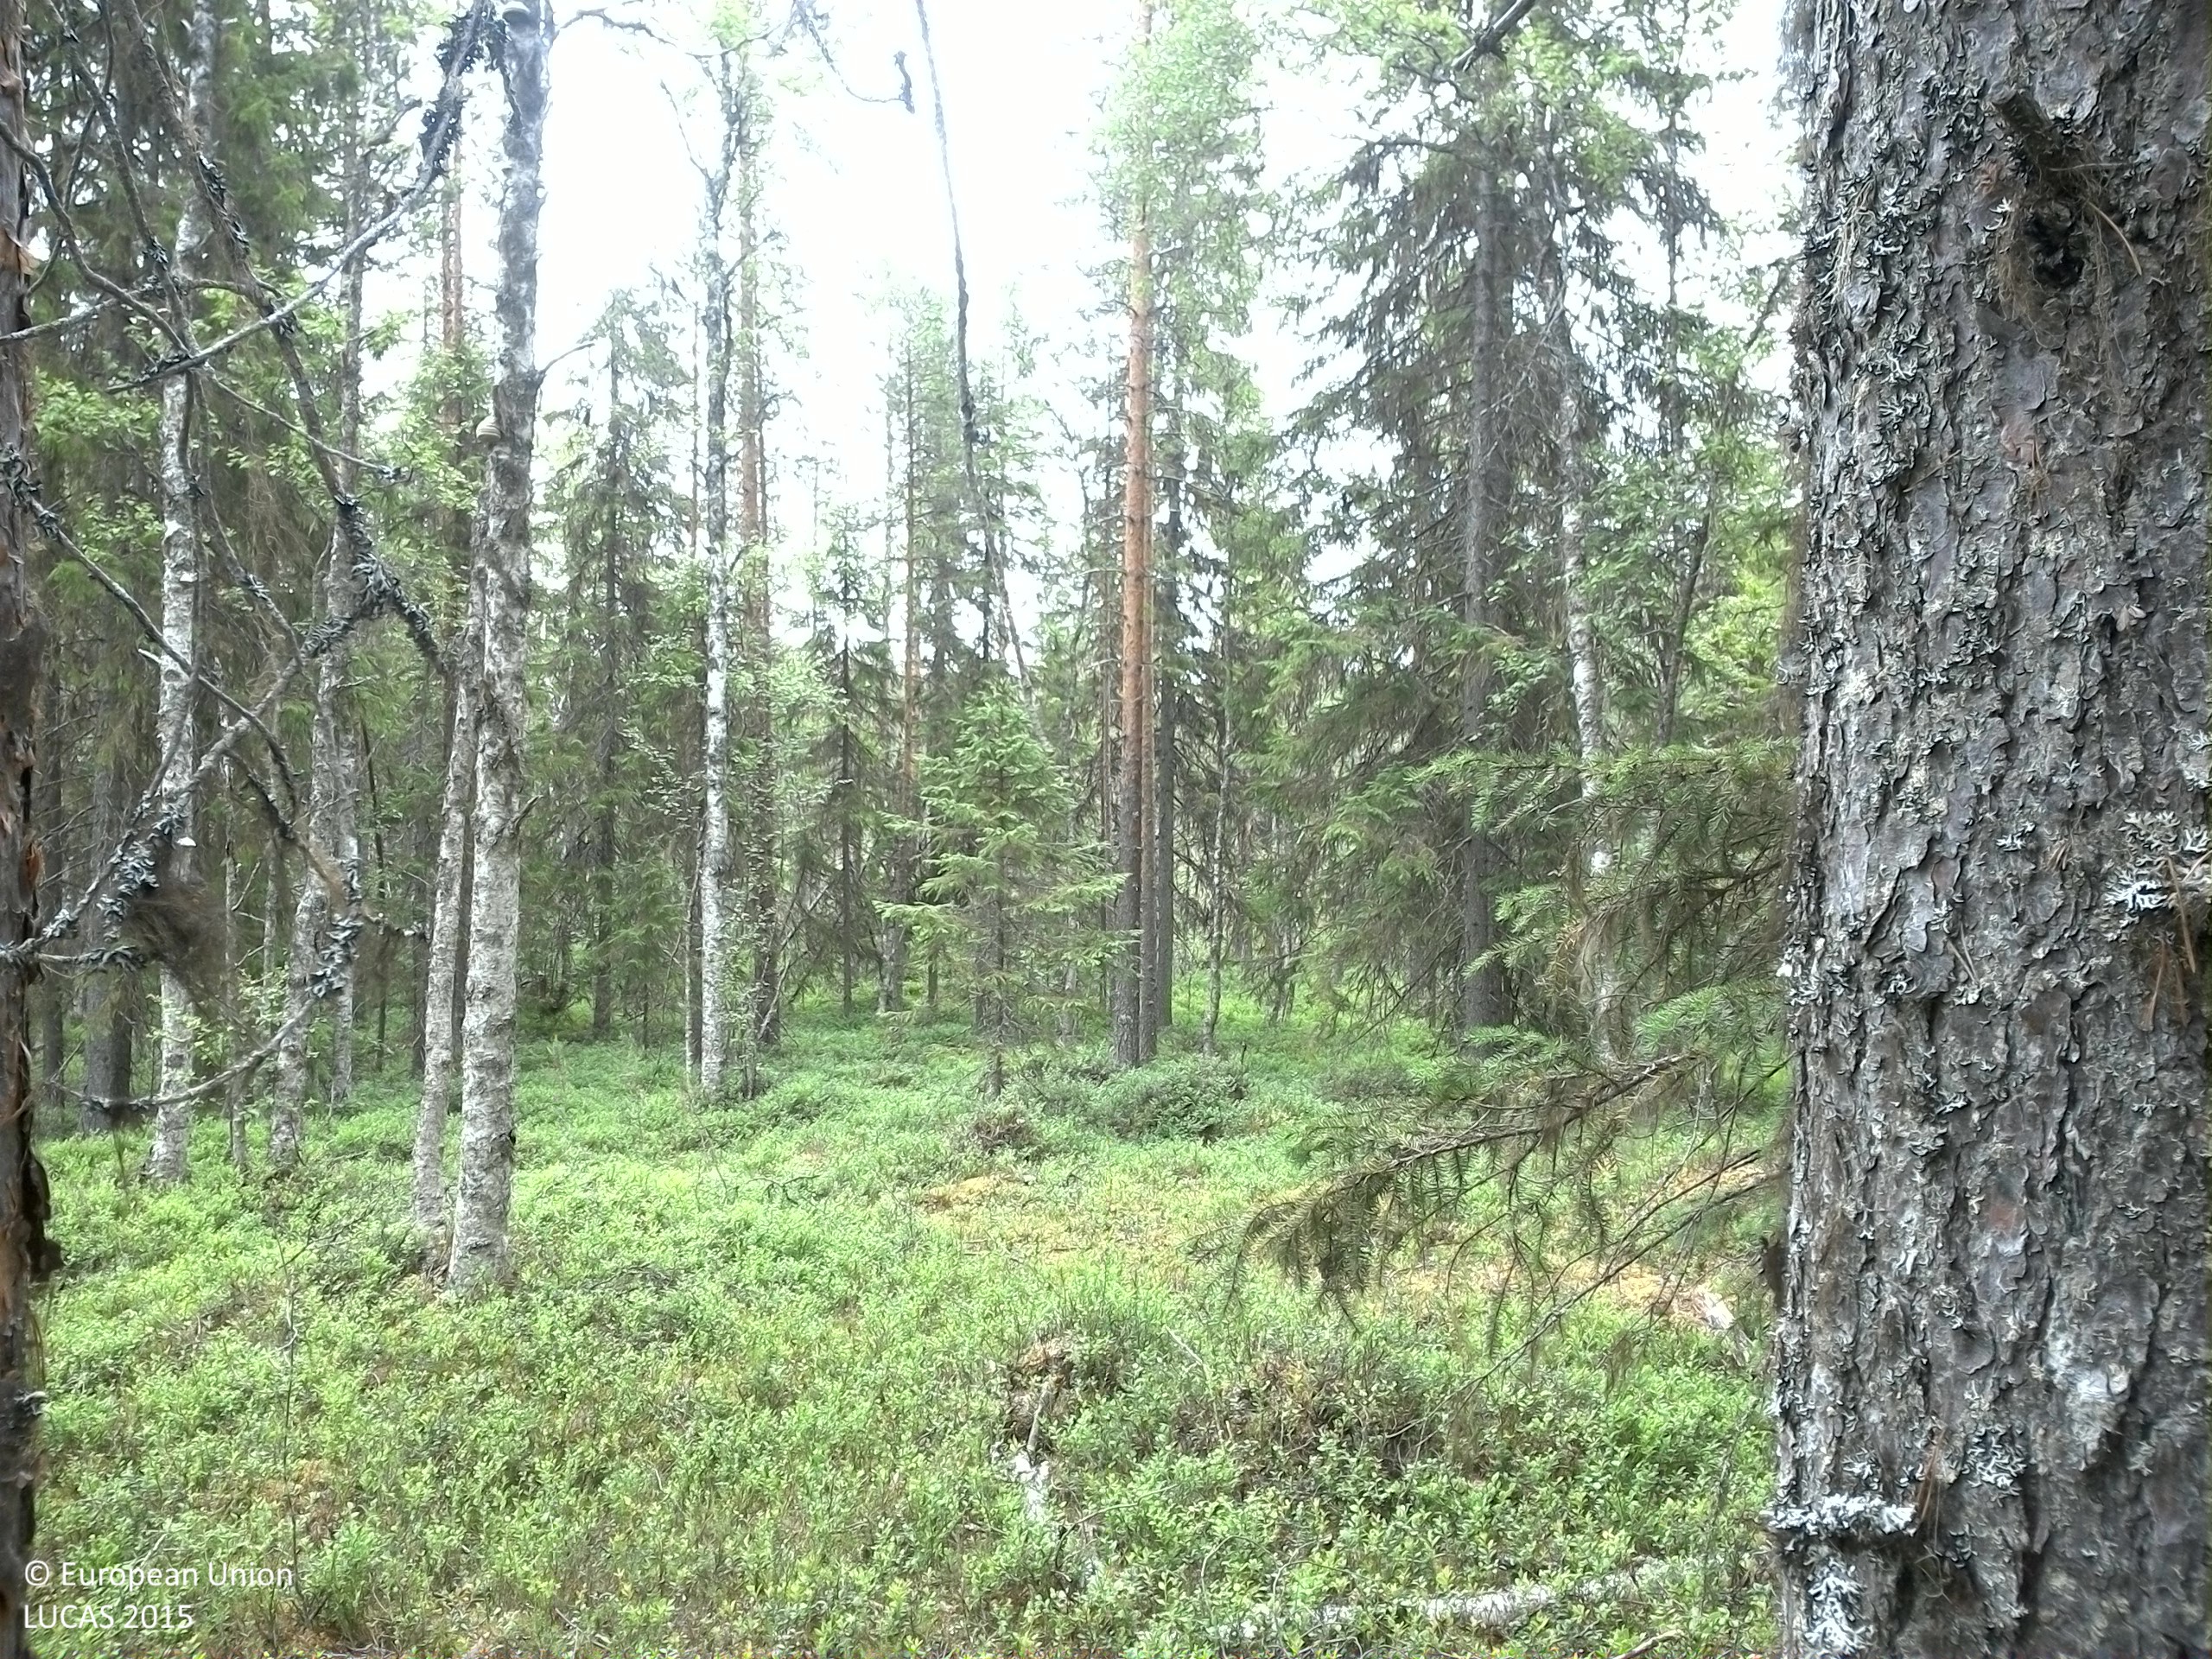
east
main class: Woodland
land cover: Pine dominated mixed woodland
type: boreal forest
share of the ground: 50 - 75 %
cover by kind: coniferous forest trees 40 %, shrubs 30 %, broadleaved forest trees 15 %, lichens and mosses 15 %
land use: Forestry
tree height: > 5 m
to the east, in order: Pine dominated mixed woodland; Pine dominated coniferous woodland; Paved roads, cycling and walking lanes; Pine dominated coniferous woodland; Ditches and canals; Pine dominated coniferous woodland; Pine dominated mixed woodland
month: July
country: SE
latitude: 63.6400
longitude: 17.5027
